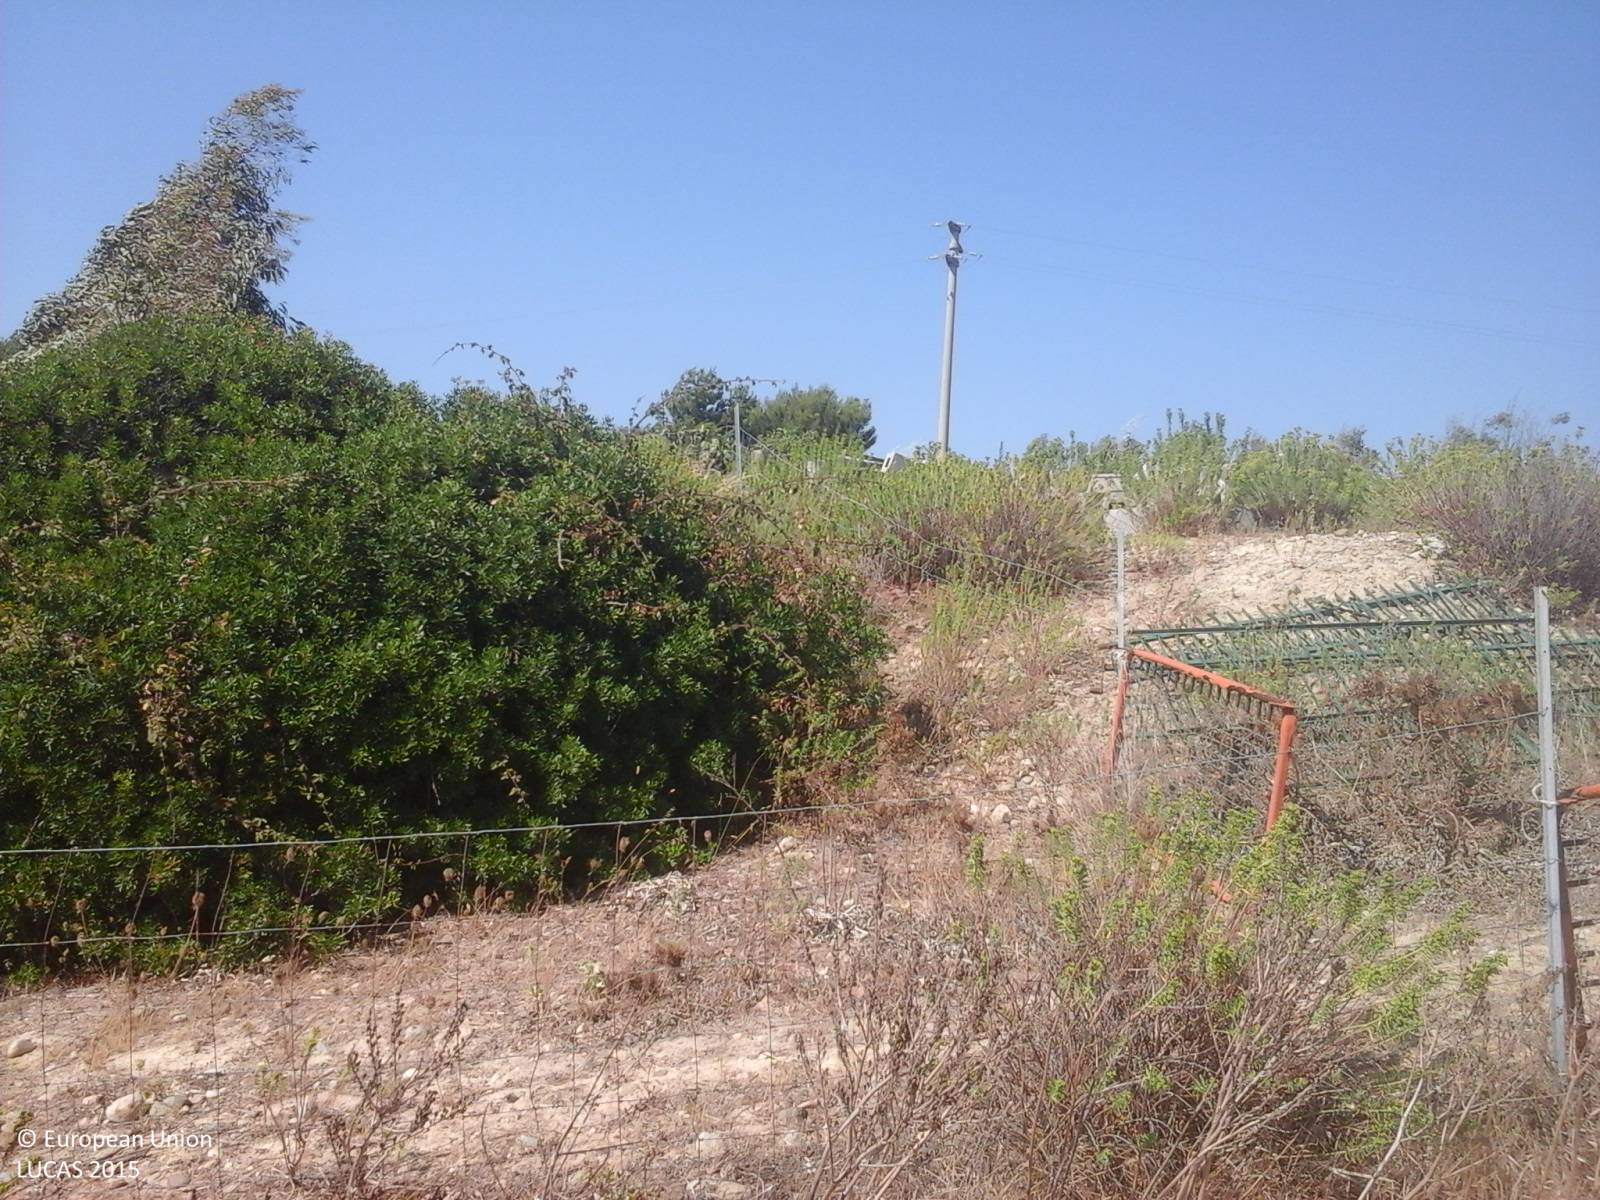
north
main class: Cropland
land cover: Barley
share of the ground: > 75 %
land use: Agriculture (excluding fallow land and kitchen gardens)
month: July
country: IT
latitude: 39.2047
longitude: 8.4693
